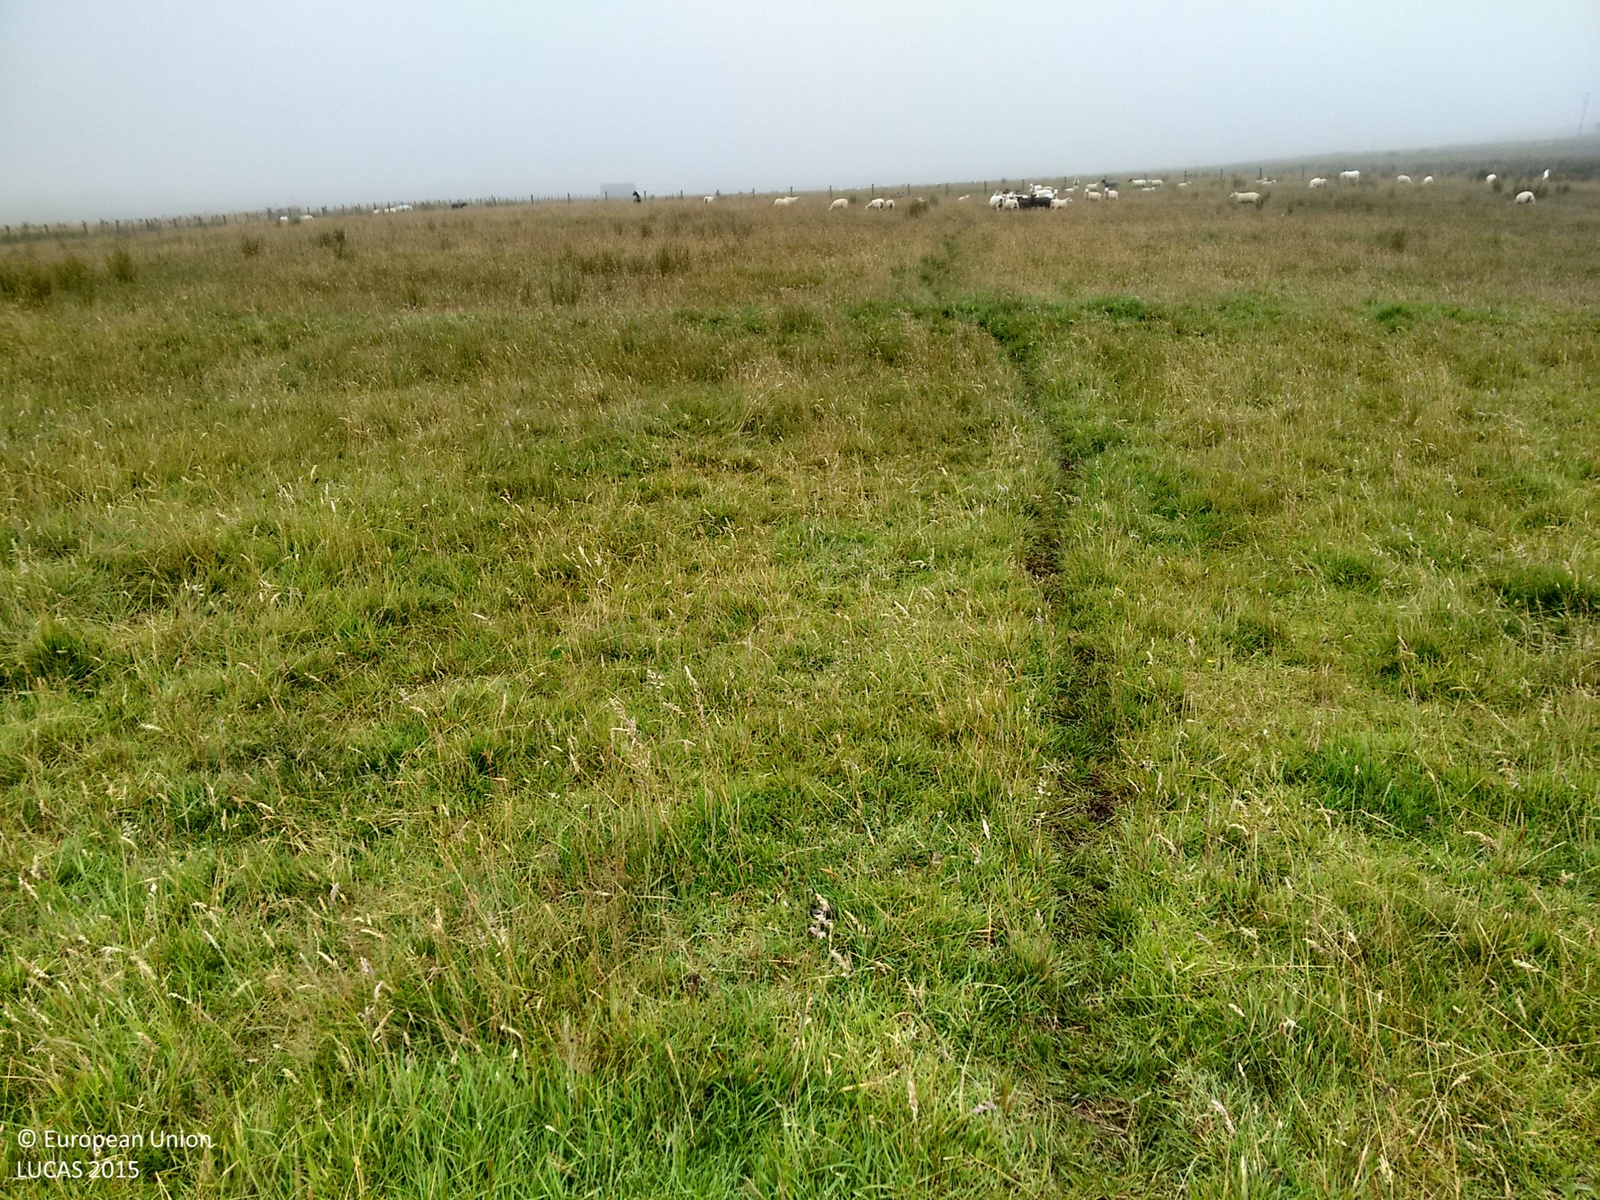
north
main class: Grassland
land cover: Grassland without tree/shrub cover
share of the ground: > 75 %
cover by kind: herbaceous plants 100 %
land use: Agriculture (excluding fallow land and kitchen gardens)
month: August
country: GB
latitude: 58.3259
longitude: -3.2600
